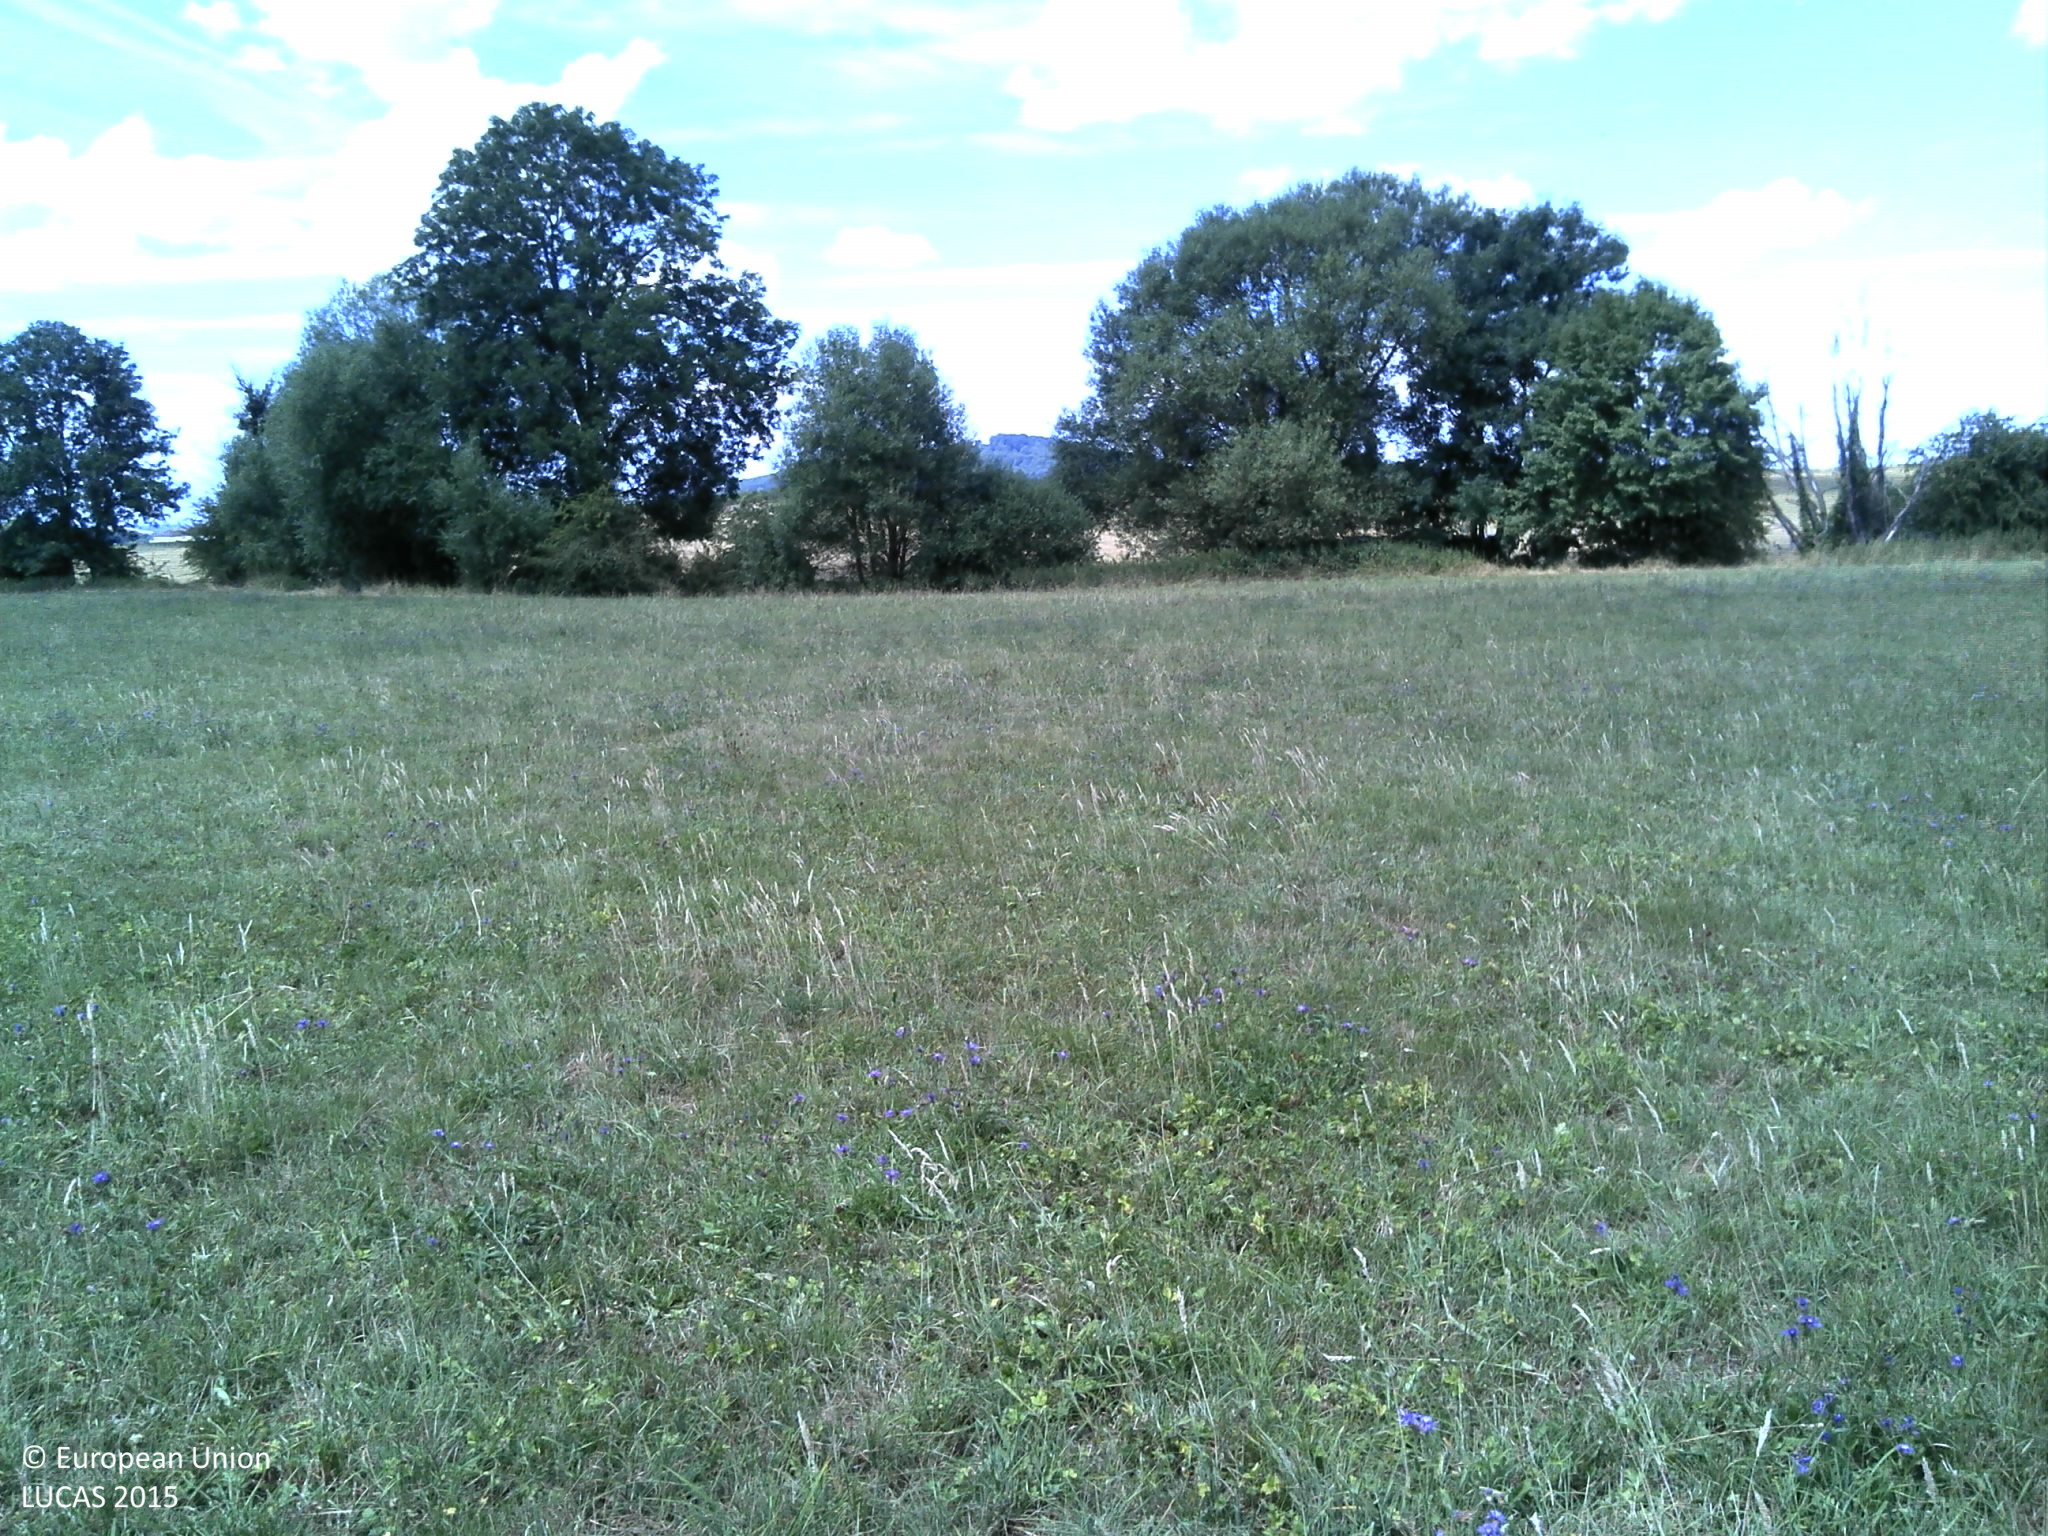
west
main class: Grassland
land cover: Grassland without tree/shrub cover
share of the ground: > 75 %
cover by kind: herbaceous plants 100 %
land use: Agriculture (excluding fallow land and kitchen gardens)
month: July
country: FR
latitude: 48.3479
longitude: 5.9656
